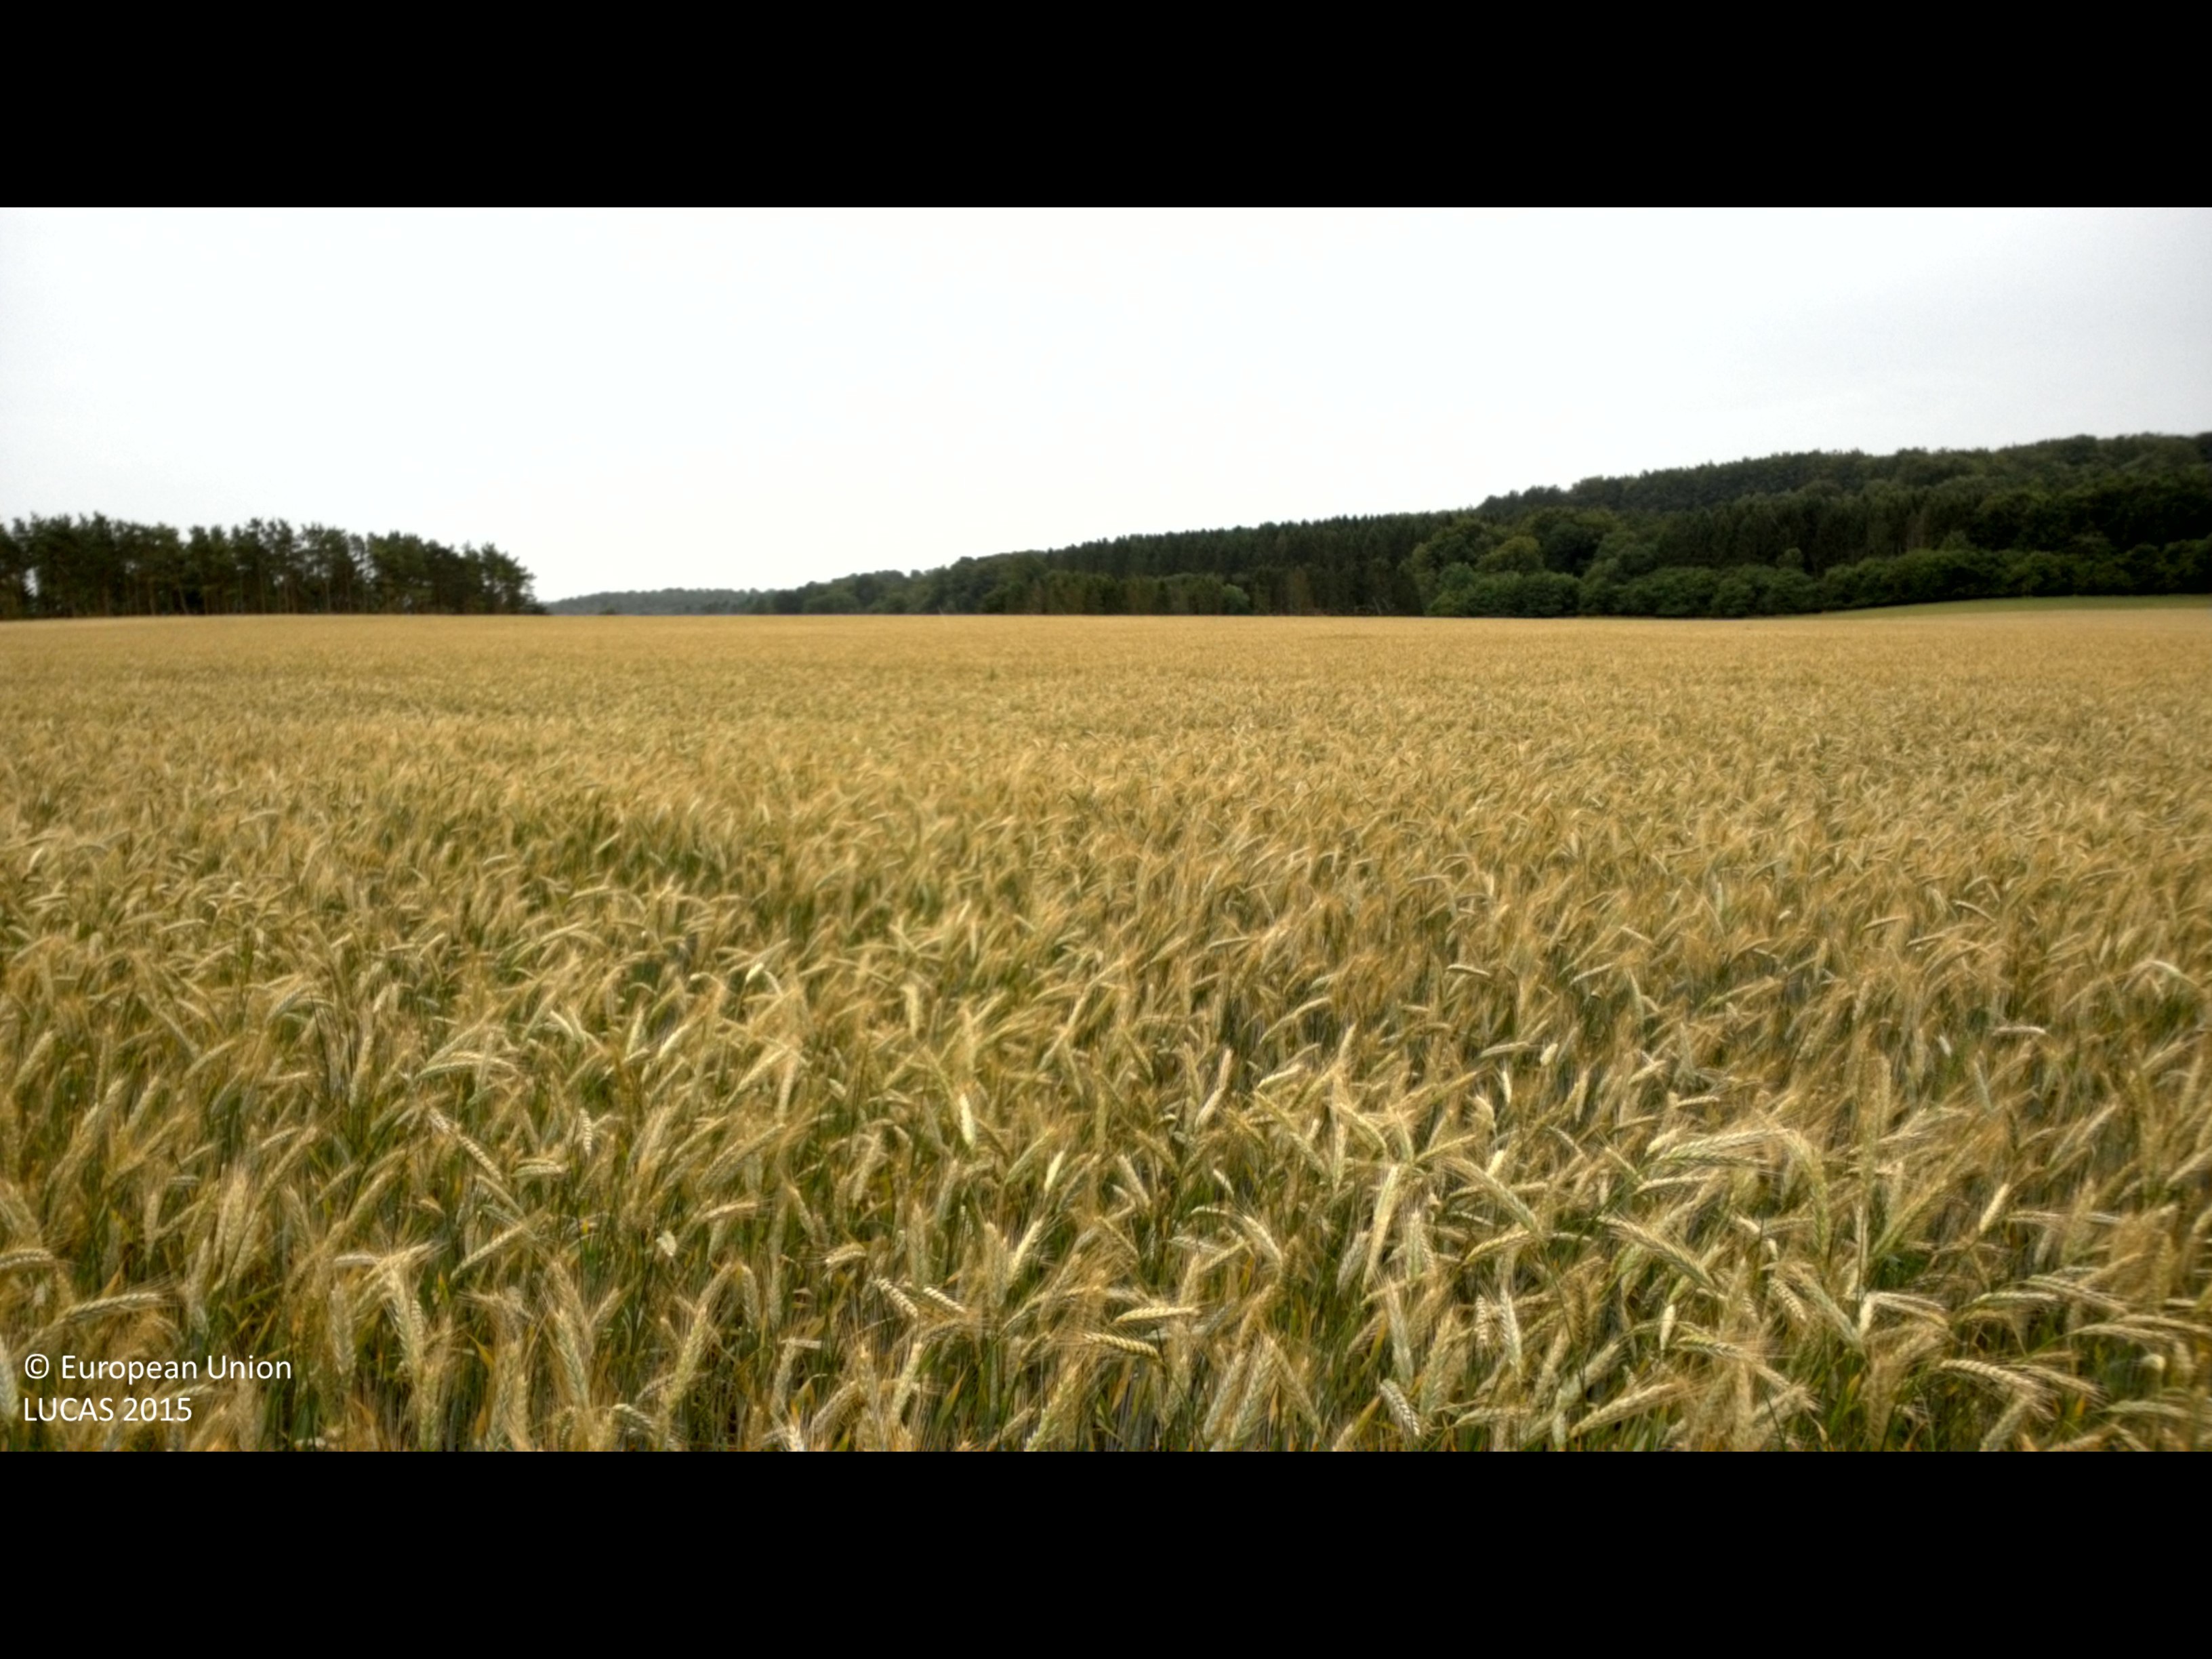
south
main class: Cropland
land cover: Rye
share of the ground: > 75 %
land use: Agriculture (excluding fallow land and kitchen gardens)
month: July
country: SE
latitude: 55.8532
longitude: 14.0715
